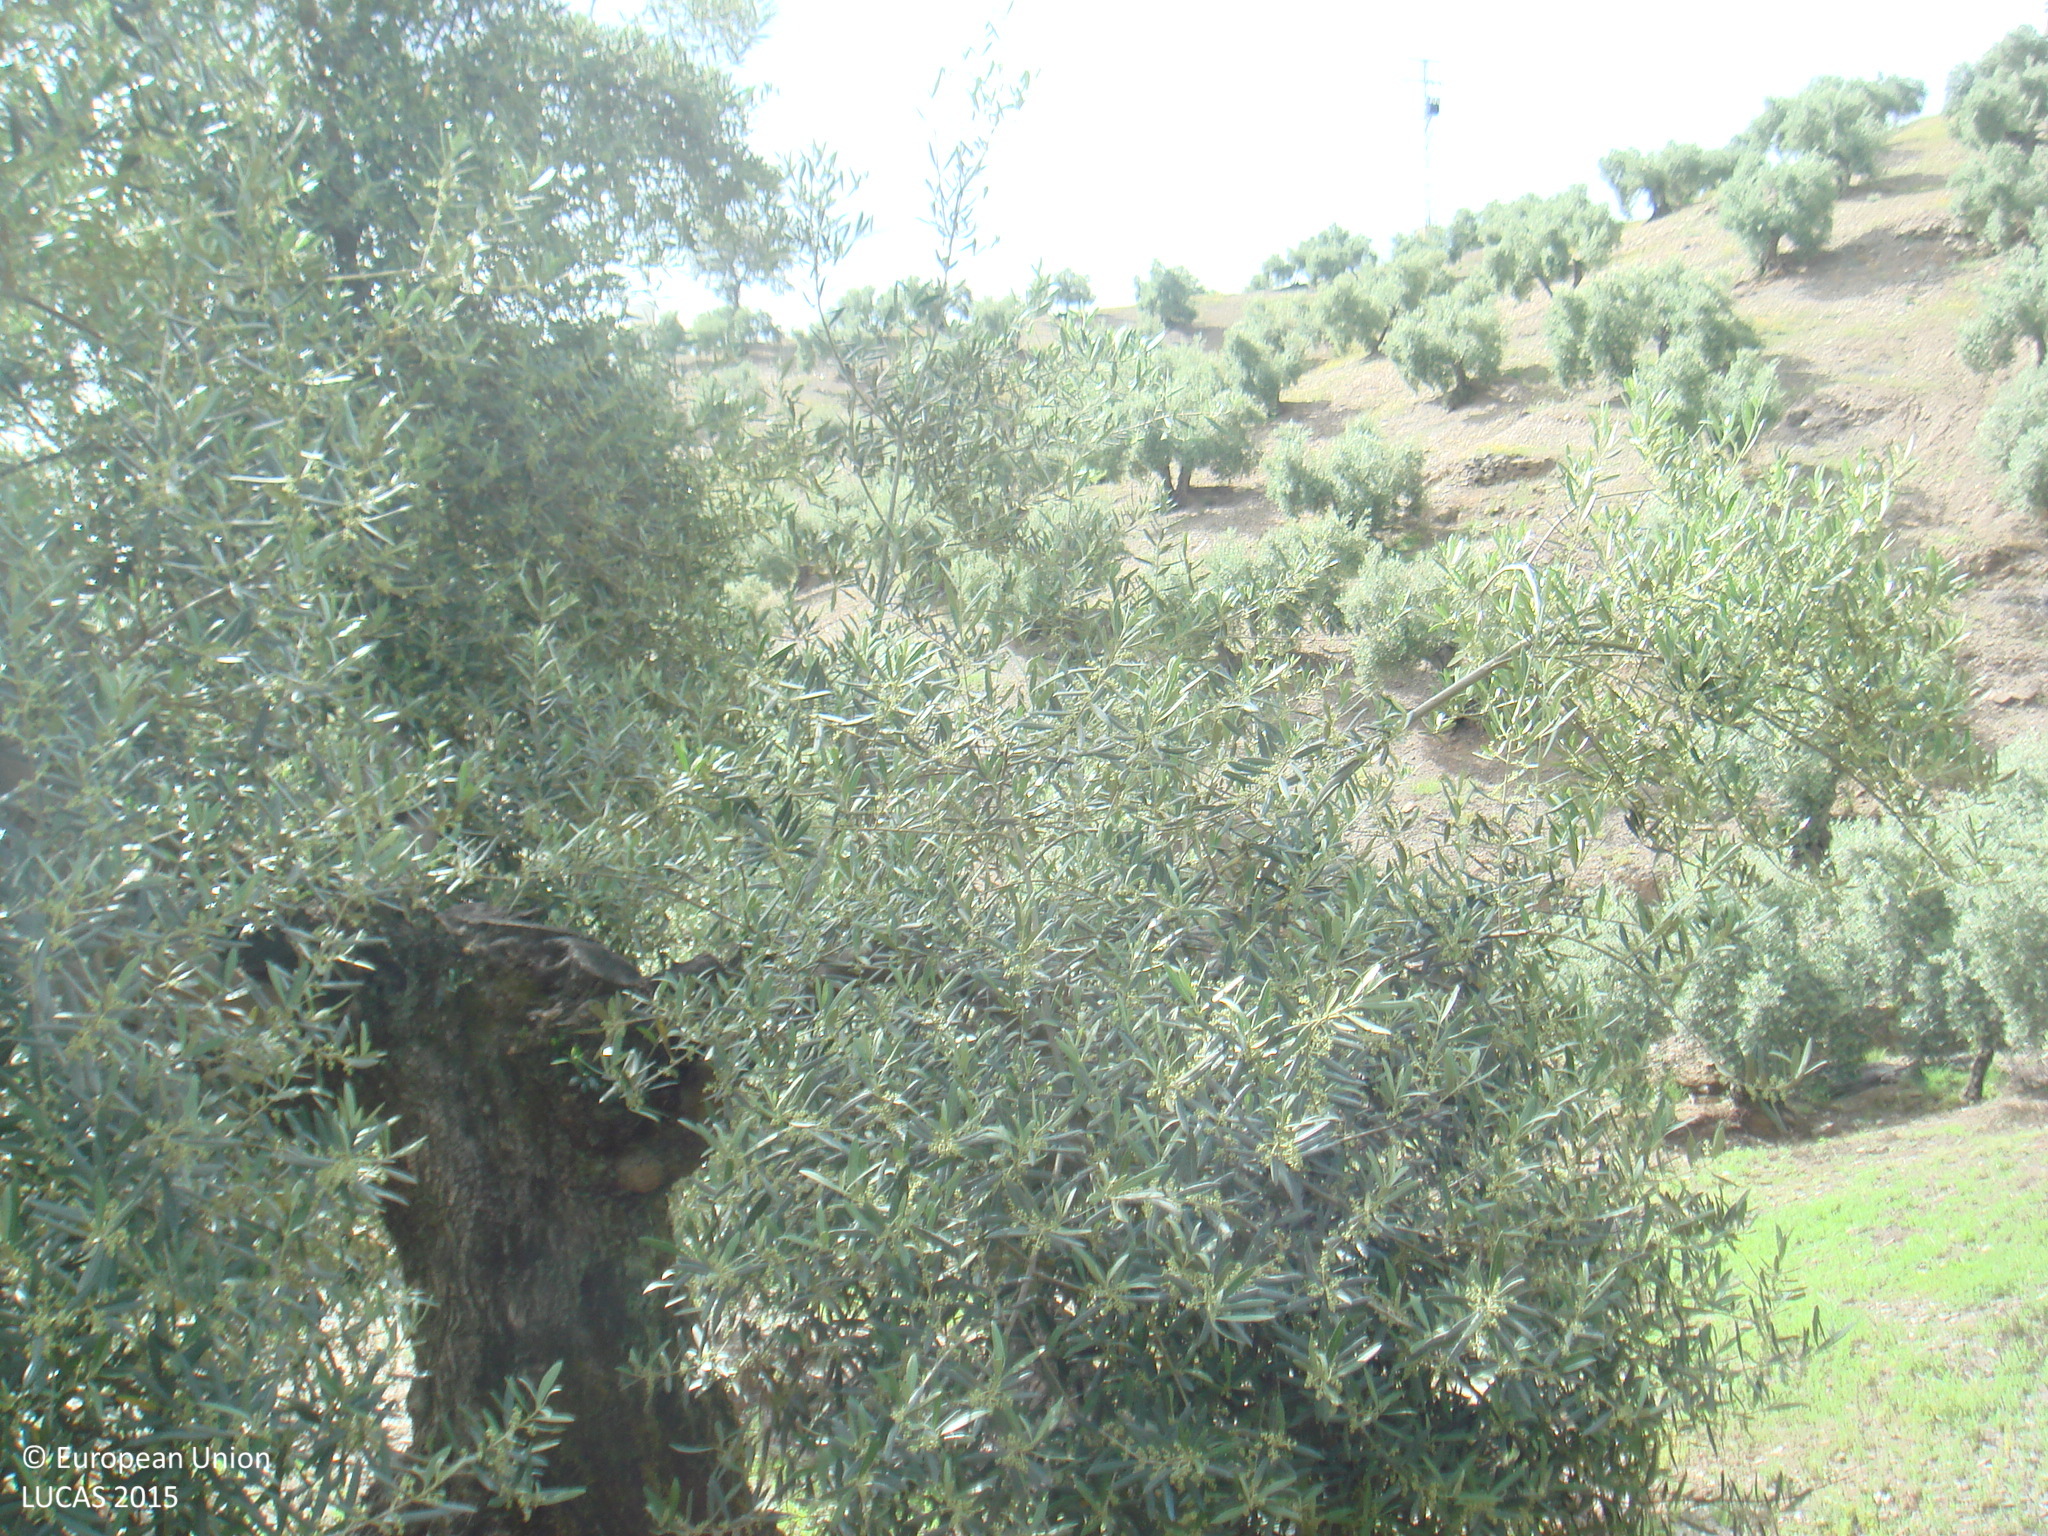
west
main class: Cropland
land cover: Olive groves
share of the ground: 50 - 75 %
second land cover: Other bare soil
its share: > 75 %
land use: Agriculture (excluding fallow land and kitchen gardens)
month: April
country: ES
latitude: 38.0909
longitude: -4.3214
